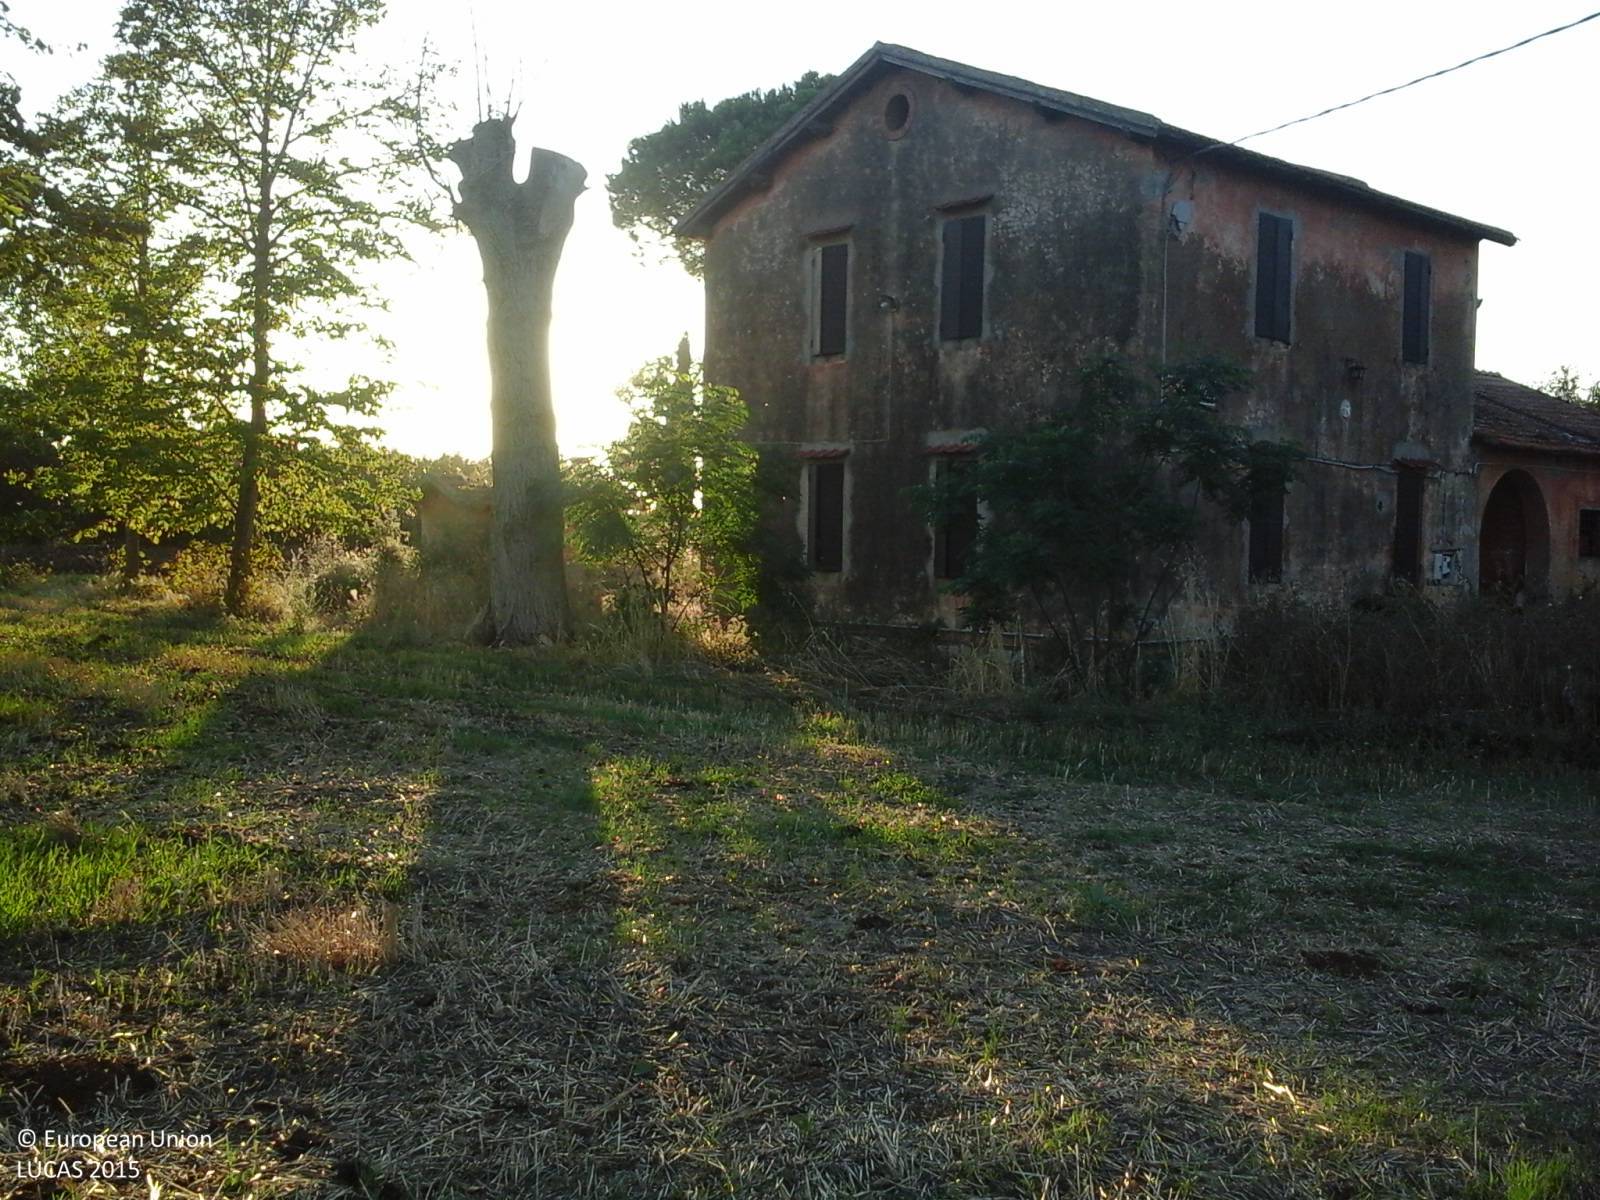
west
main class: Cropland
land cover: Common wheat
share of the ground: < 10 %
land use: Agriculture (excluding fallow land and kitchen gardens)
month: August
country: IT
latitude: 41.3752
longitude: 13.1558
